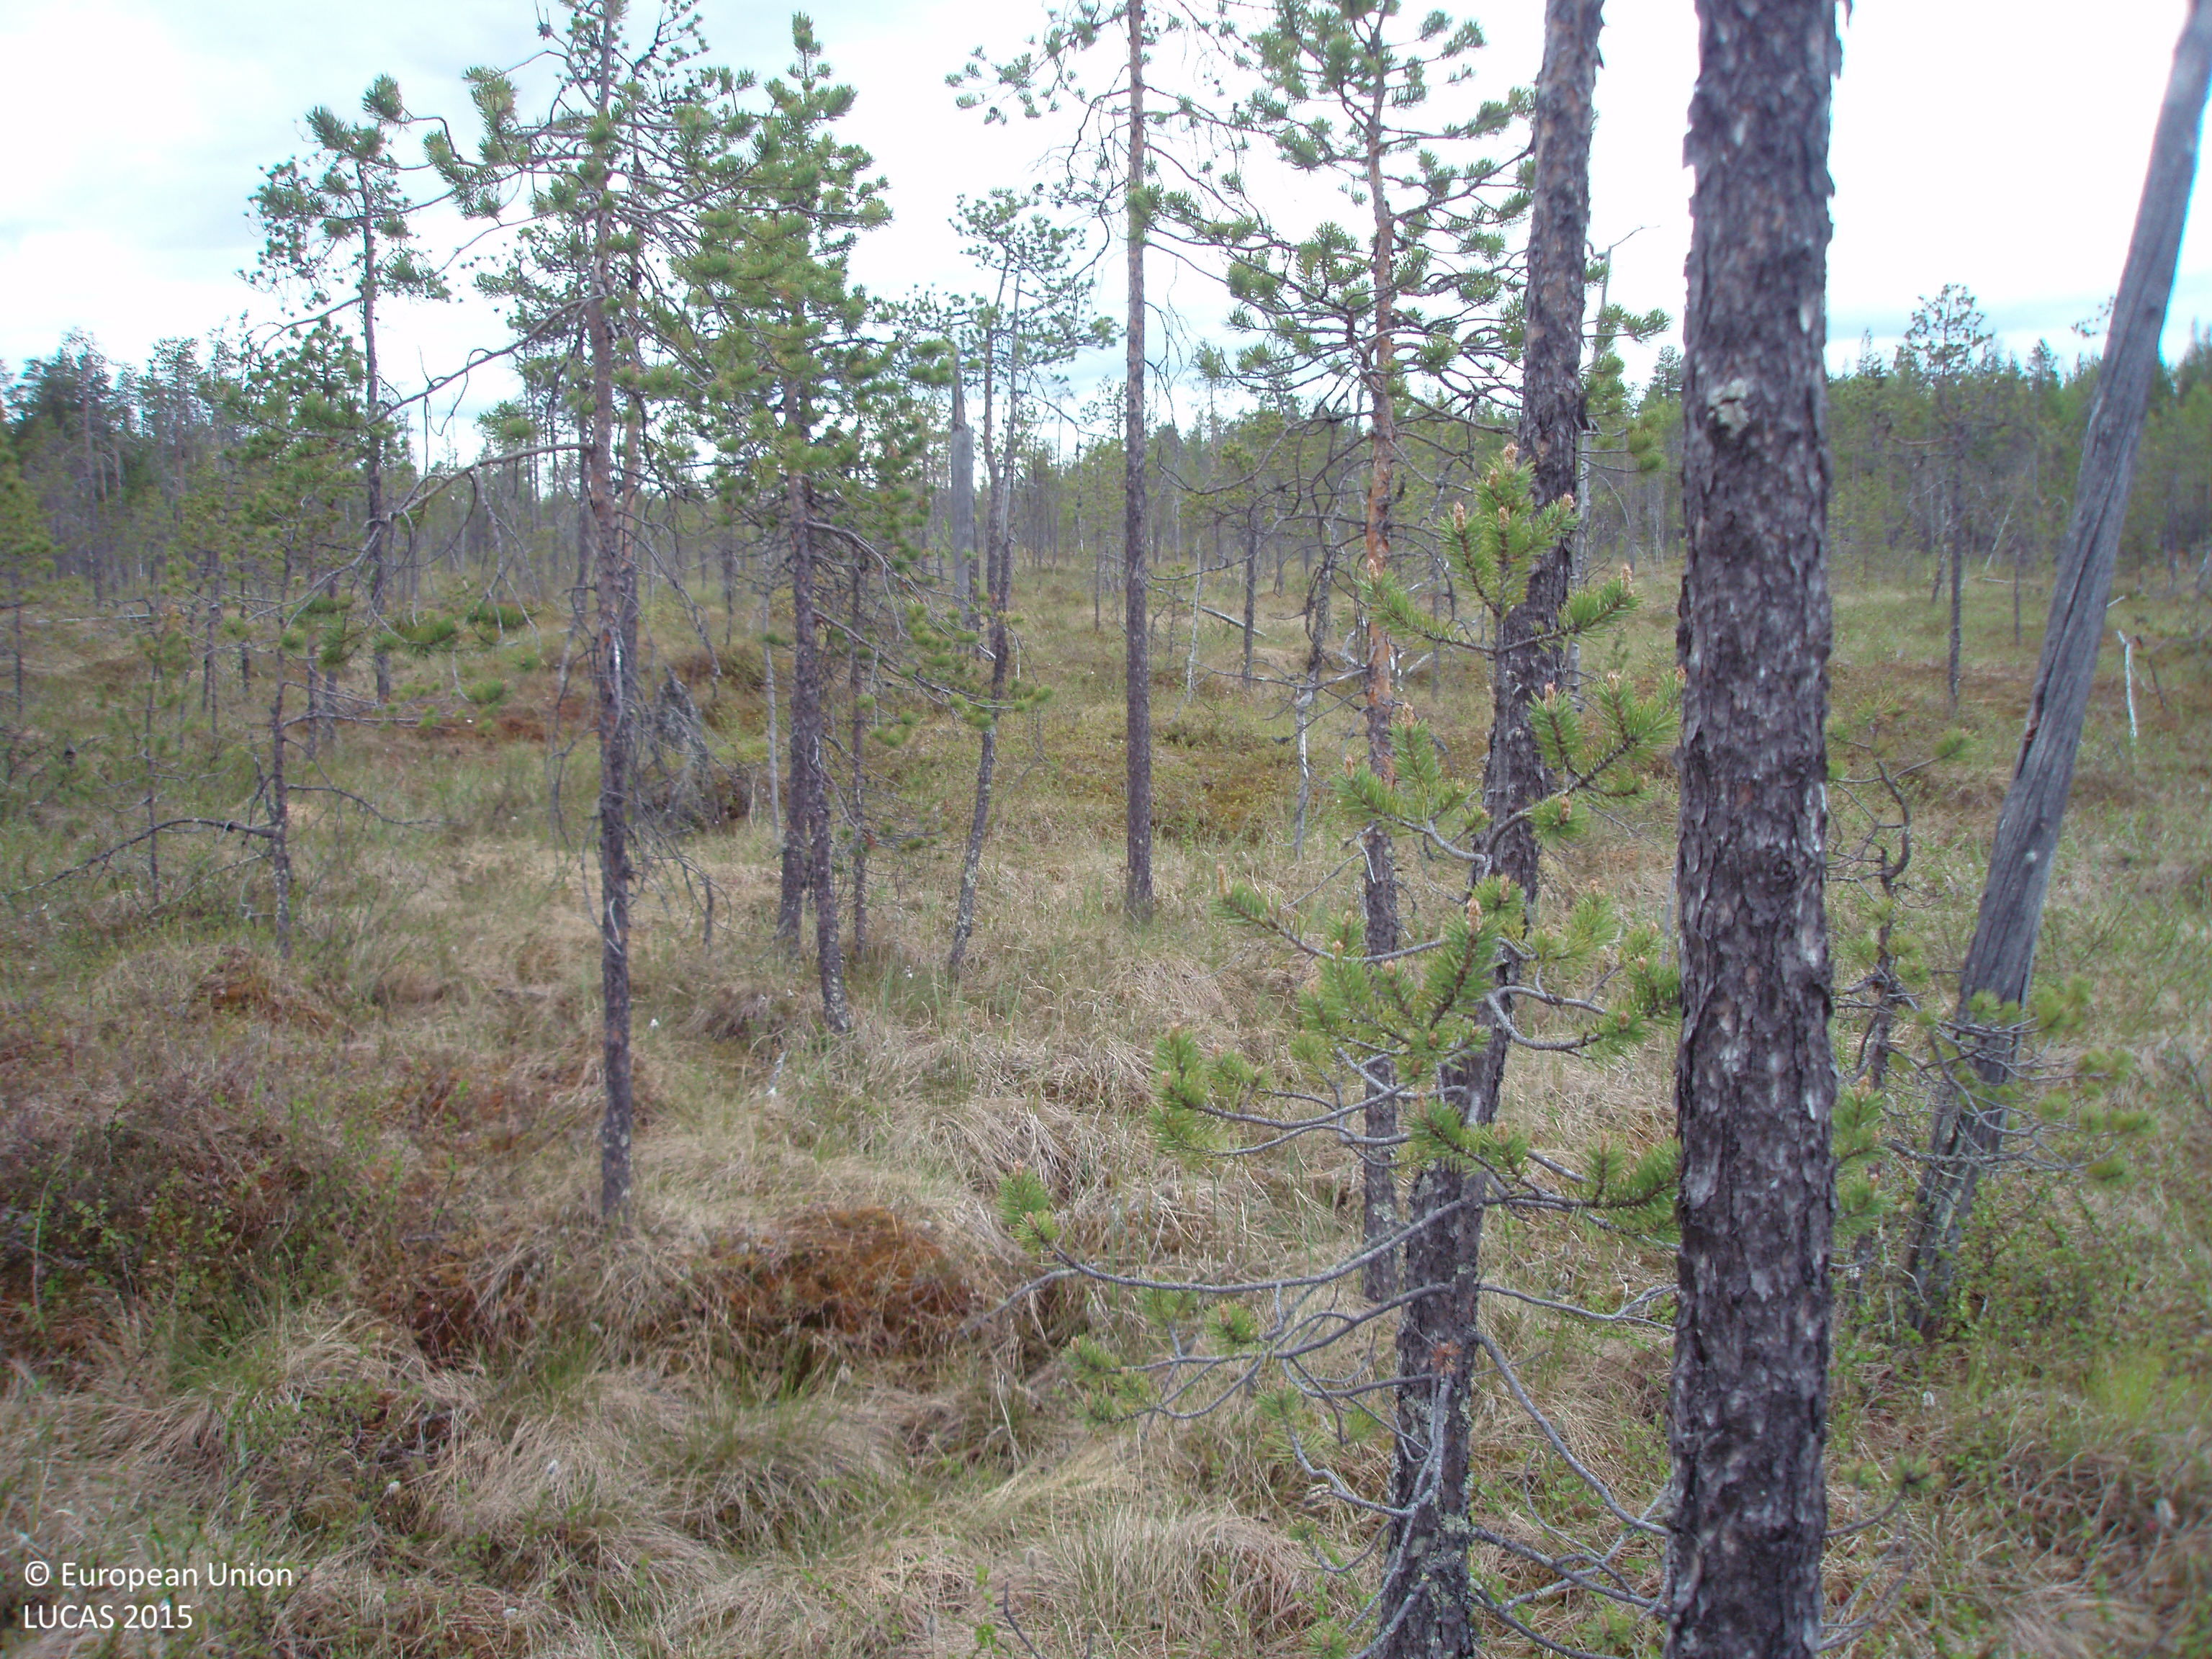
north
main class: Woodland
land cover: Pine dominated coniferous woodland
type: boreal forest
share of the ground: 10 - 25 %
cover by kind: shrubs 50 %, herbaceous plants 30 %, coniferous forest trees 20 %
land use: Semi-natural and natural areas not in use
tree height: > 5 m
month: June
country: FI
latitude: 67.2370
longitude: 27.3048
